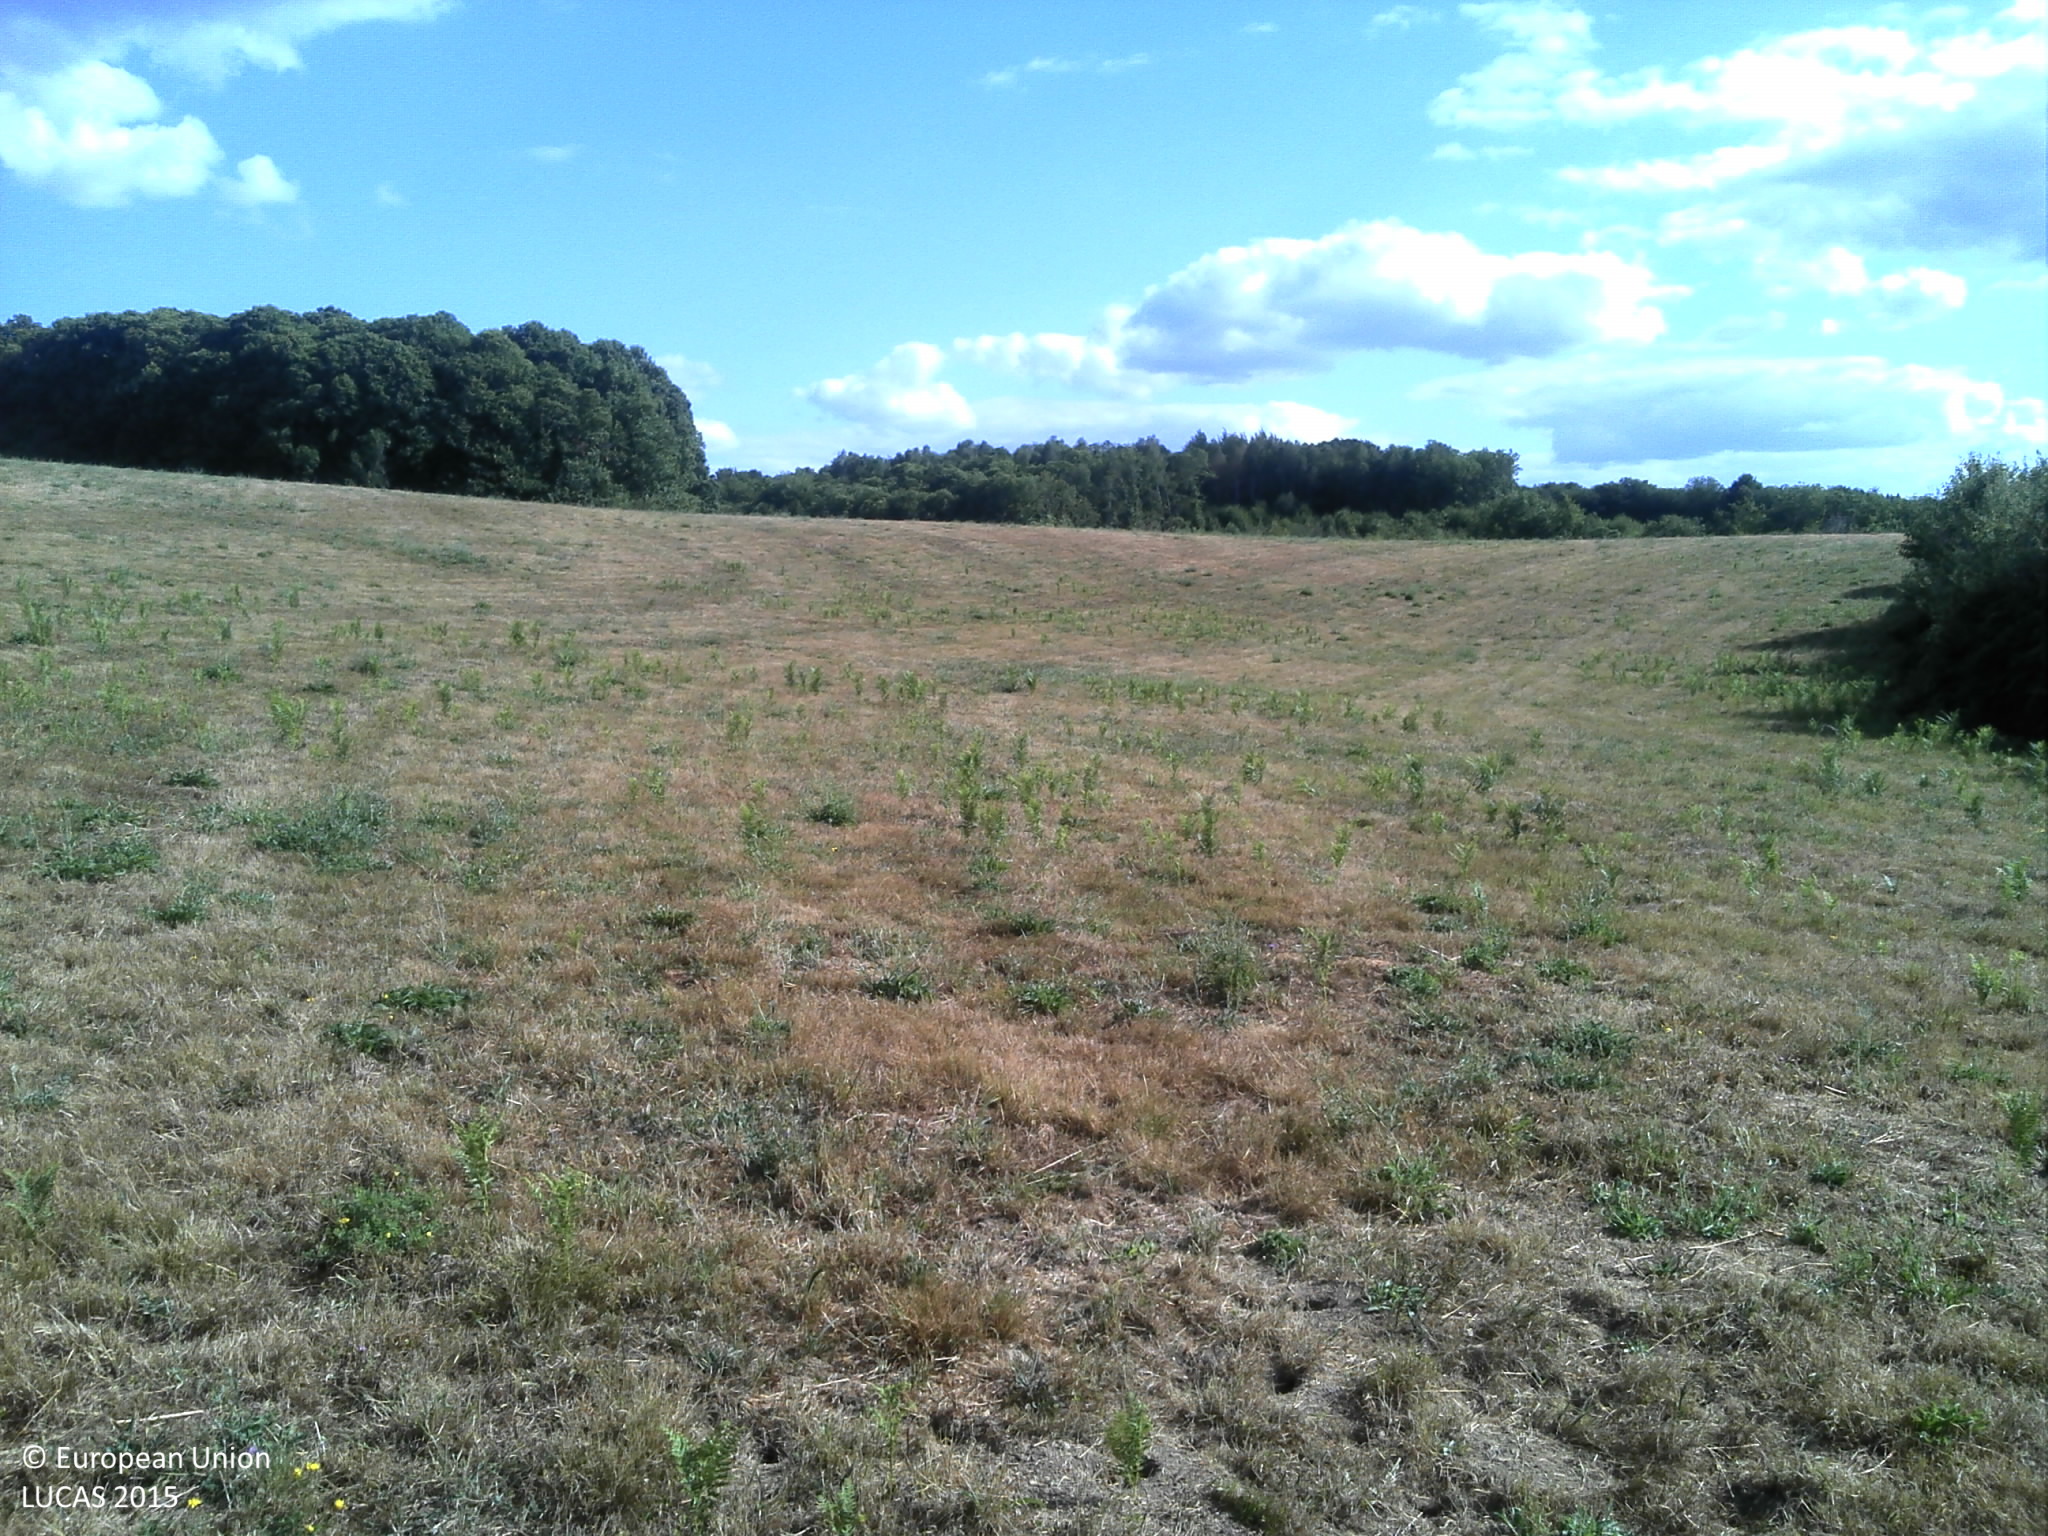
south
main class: Grassland
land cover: Grassland without tree/shrub cover
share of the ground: > 75 %
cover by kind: herbaceous plants 100 %
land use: Agriculture (excluding fallow land and kitchen gardens)
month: July
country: FR
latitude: 45.1801
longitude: 1.7372
